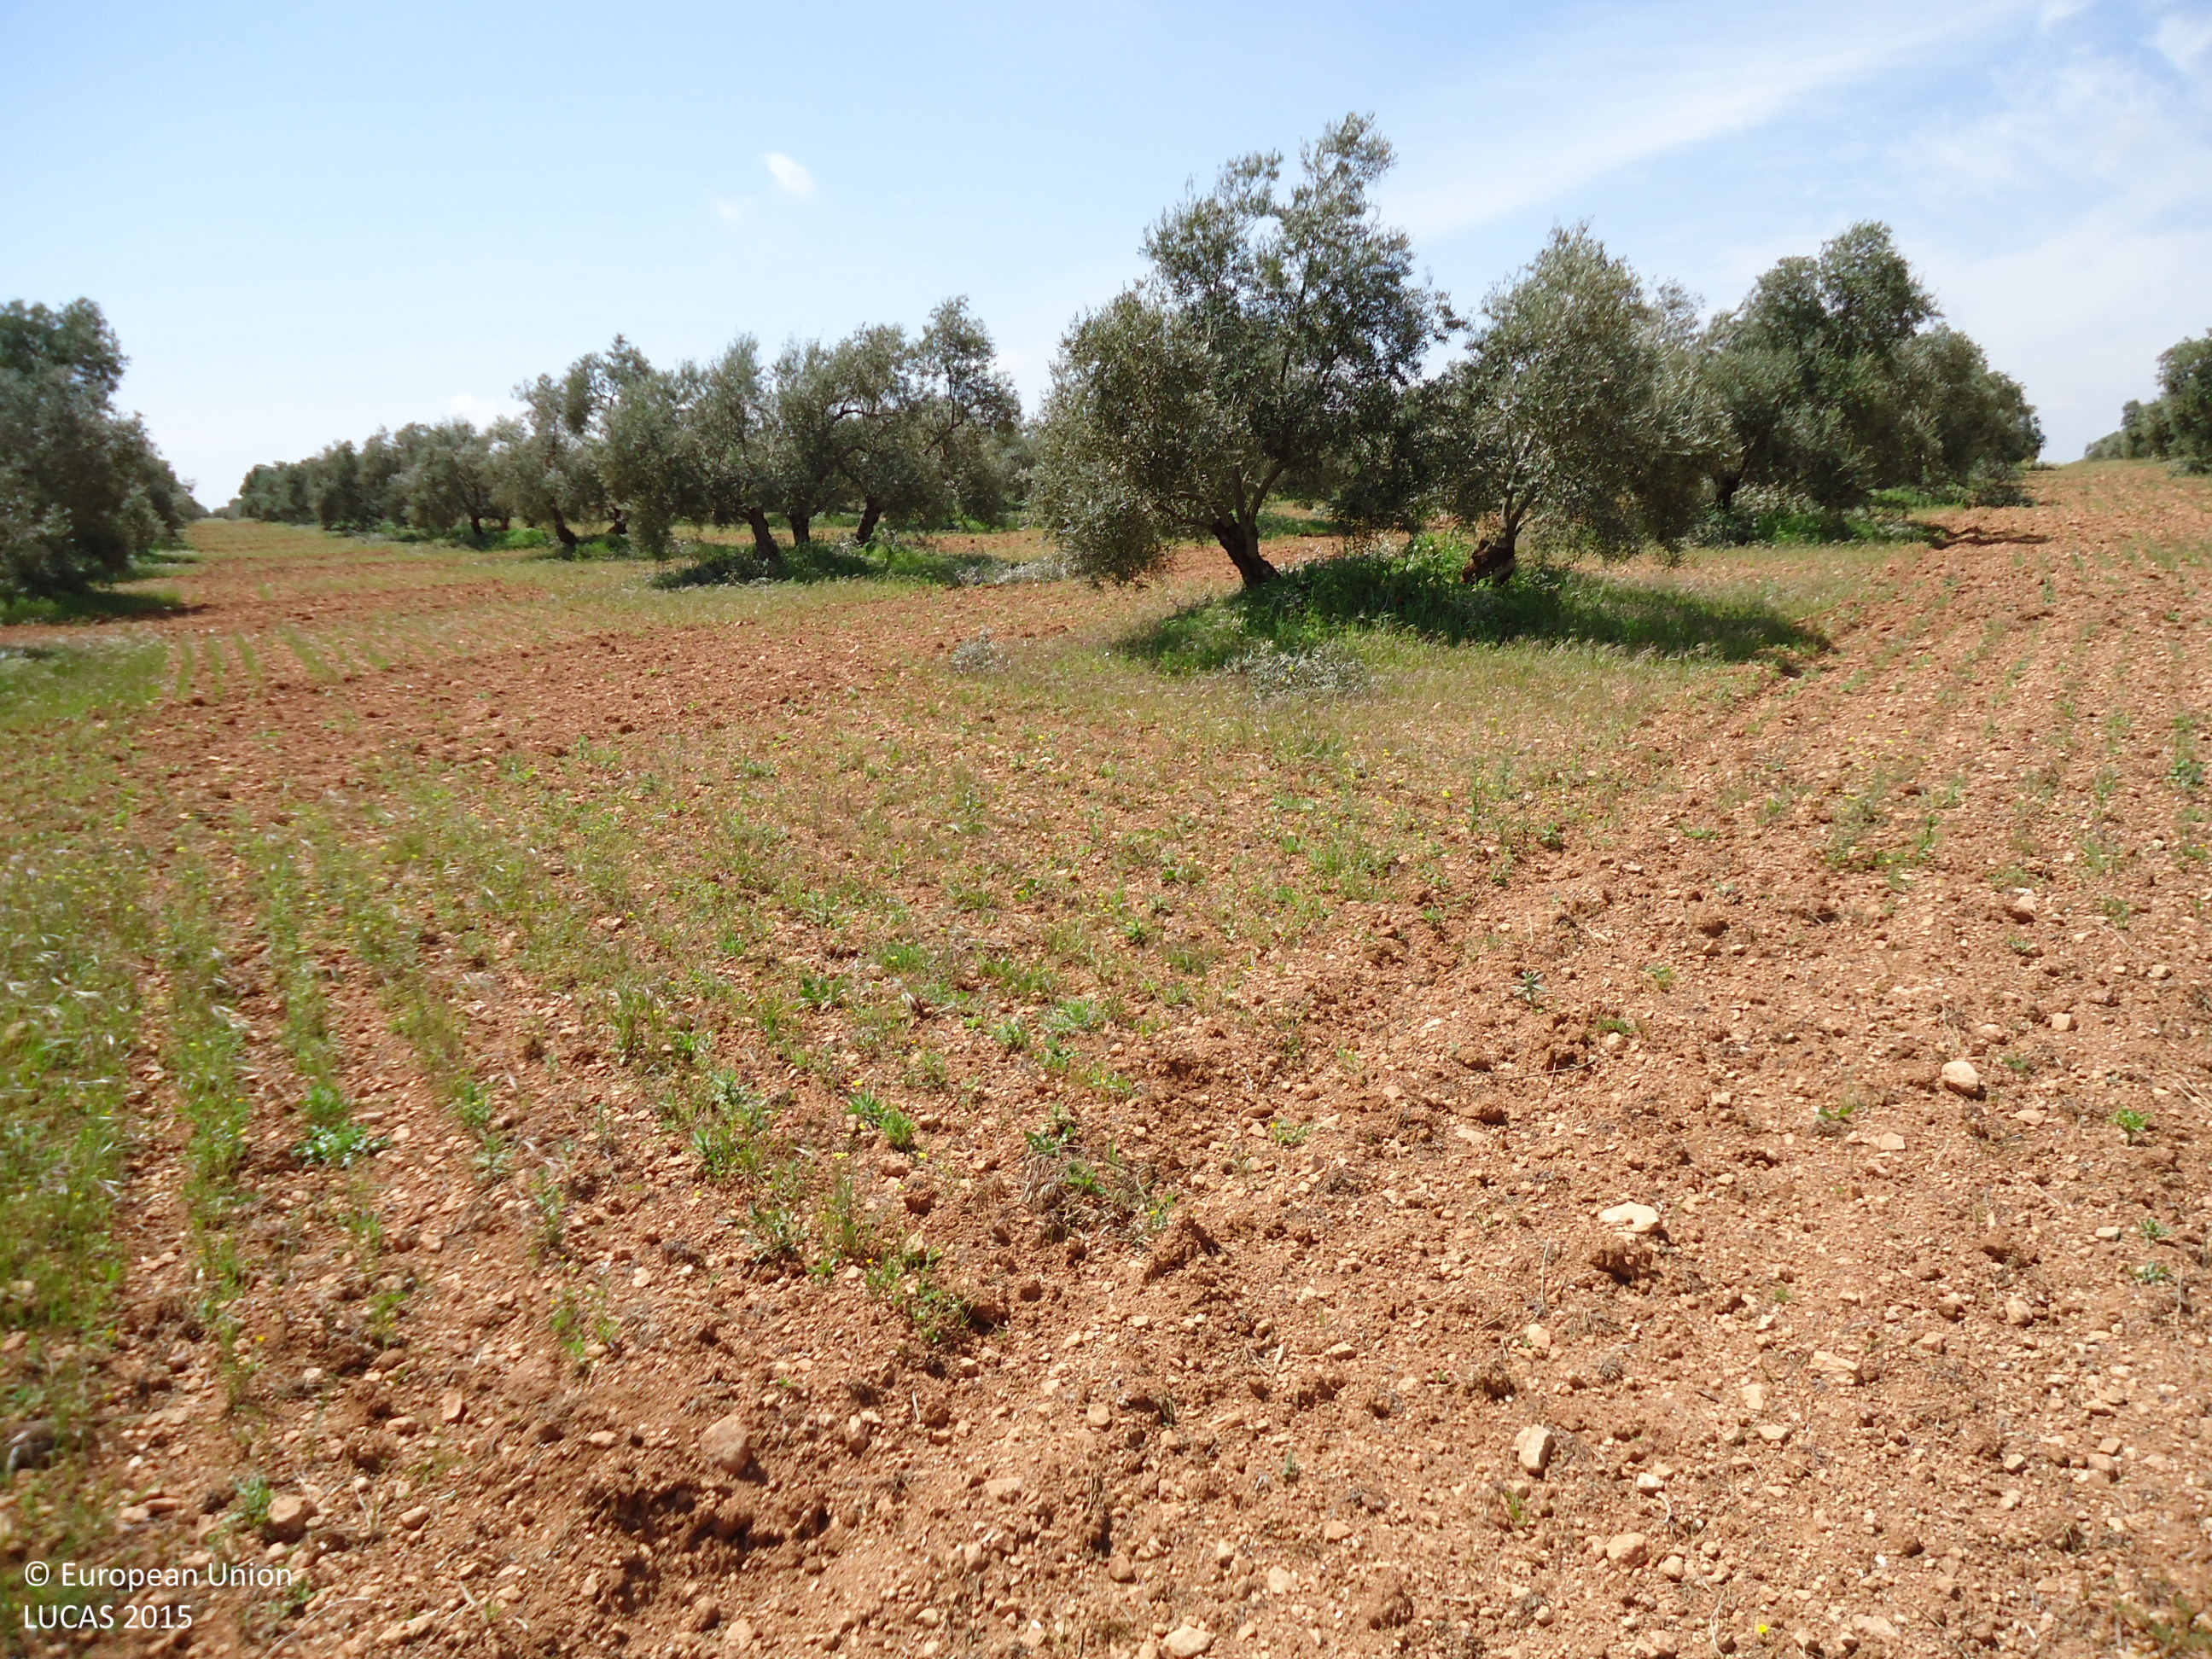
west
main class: Cropland
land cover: Olive groves
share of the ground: 10 - 25 %
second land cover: Spontaneously vegetated surfaces
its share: > 75 %
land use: Agriculture (excluding fallow land and kitchen gardens)
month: April
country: ES
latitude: 37.0770
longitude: -4.8149
